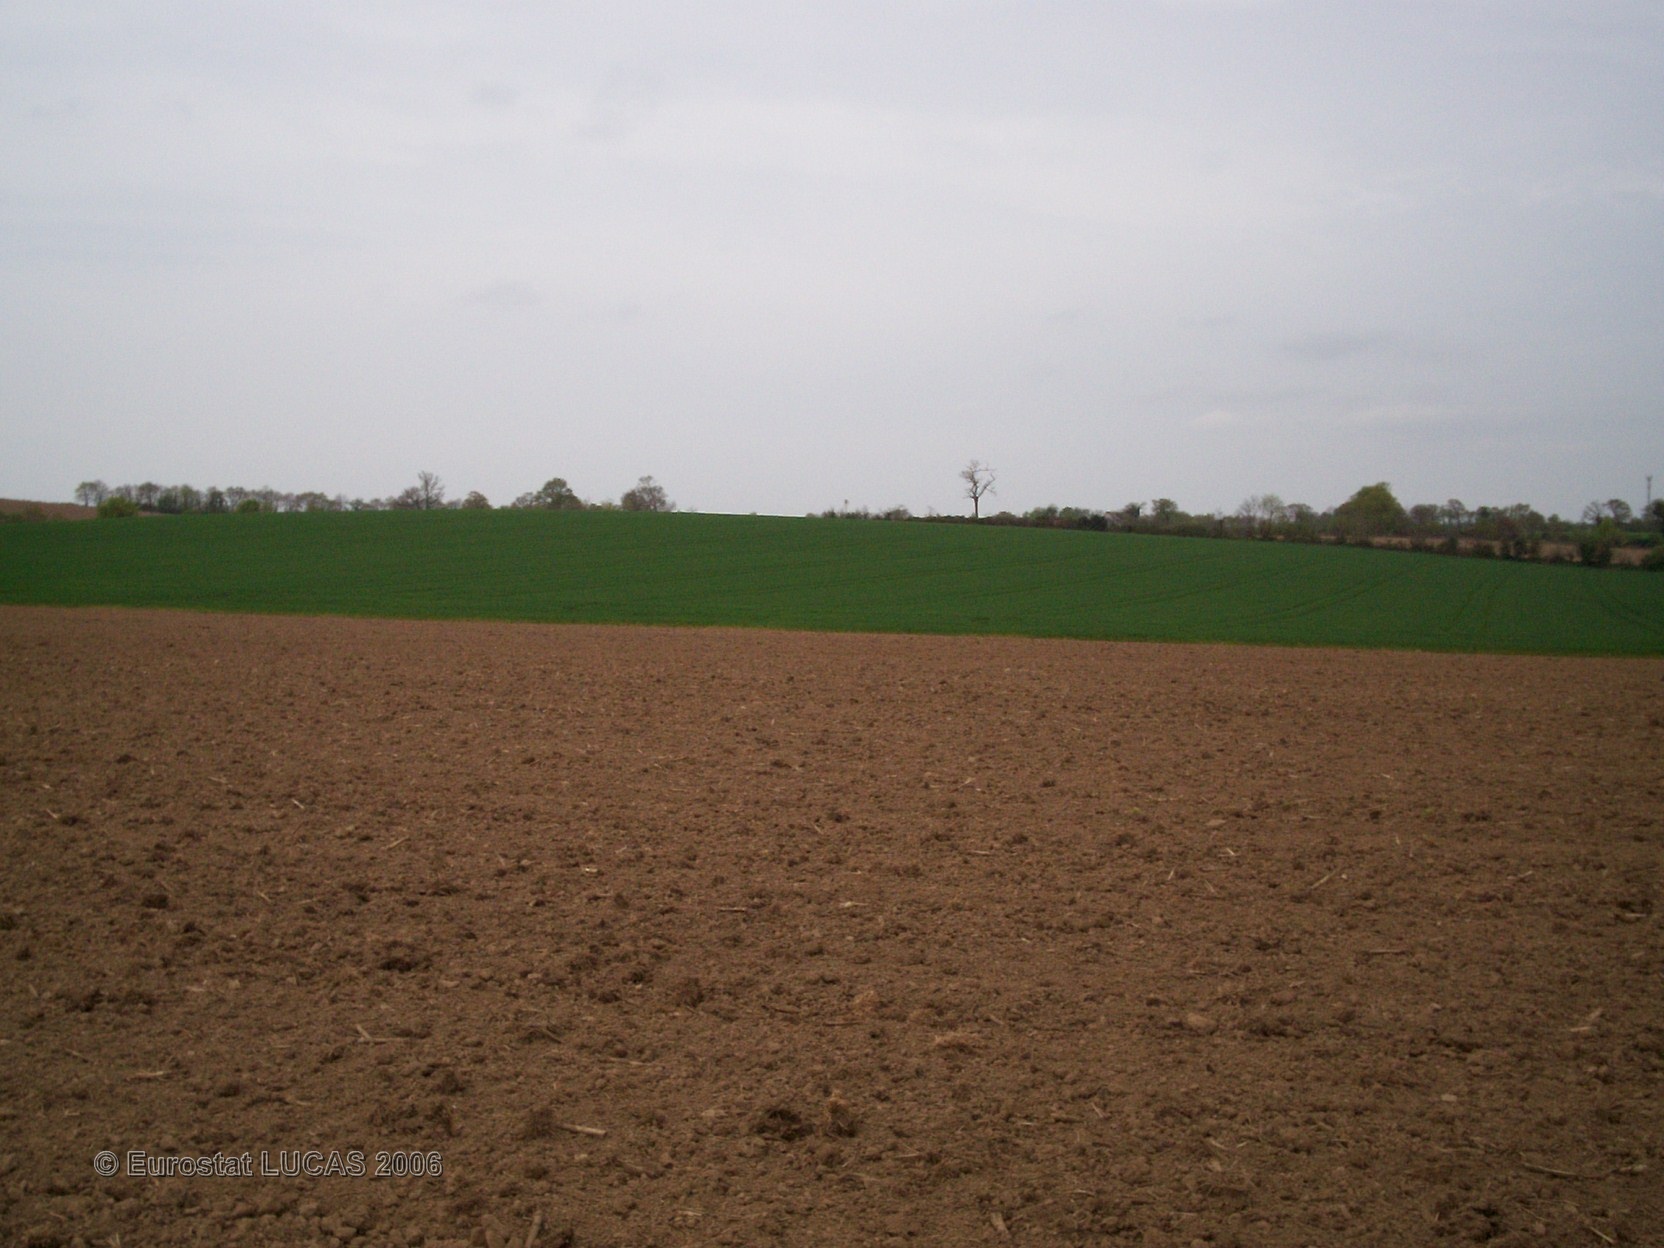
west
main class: Cropland
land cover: Maize
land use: Agriculture (excluding fallow land and kitchen gardens)
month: May
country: FR
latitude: 48.2273
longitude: -3.9383
